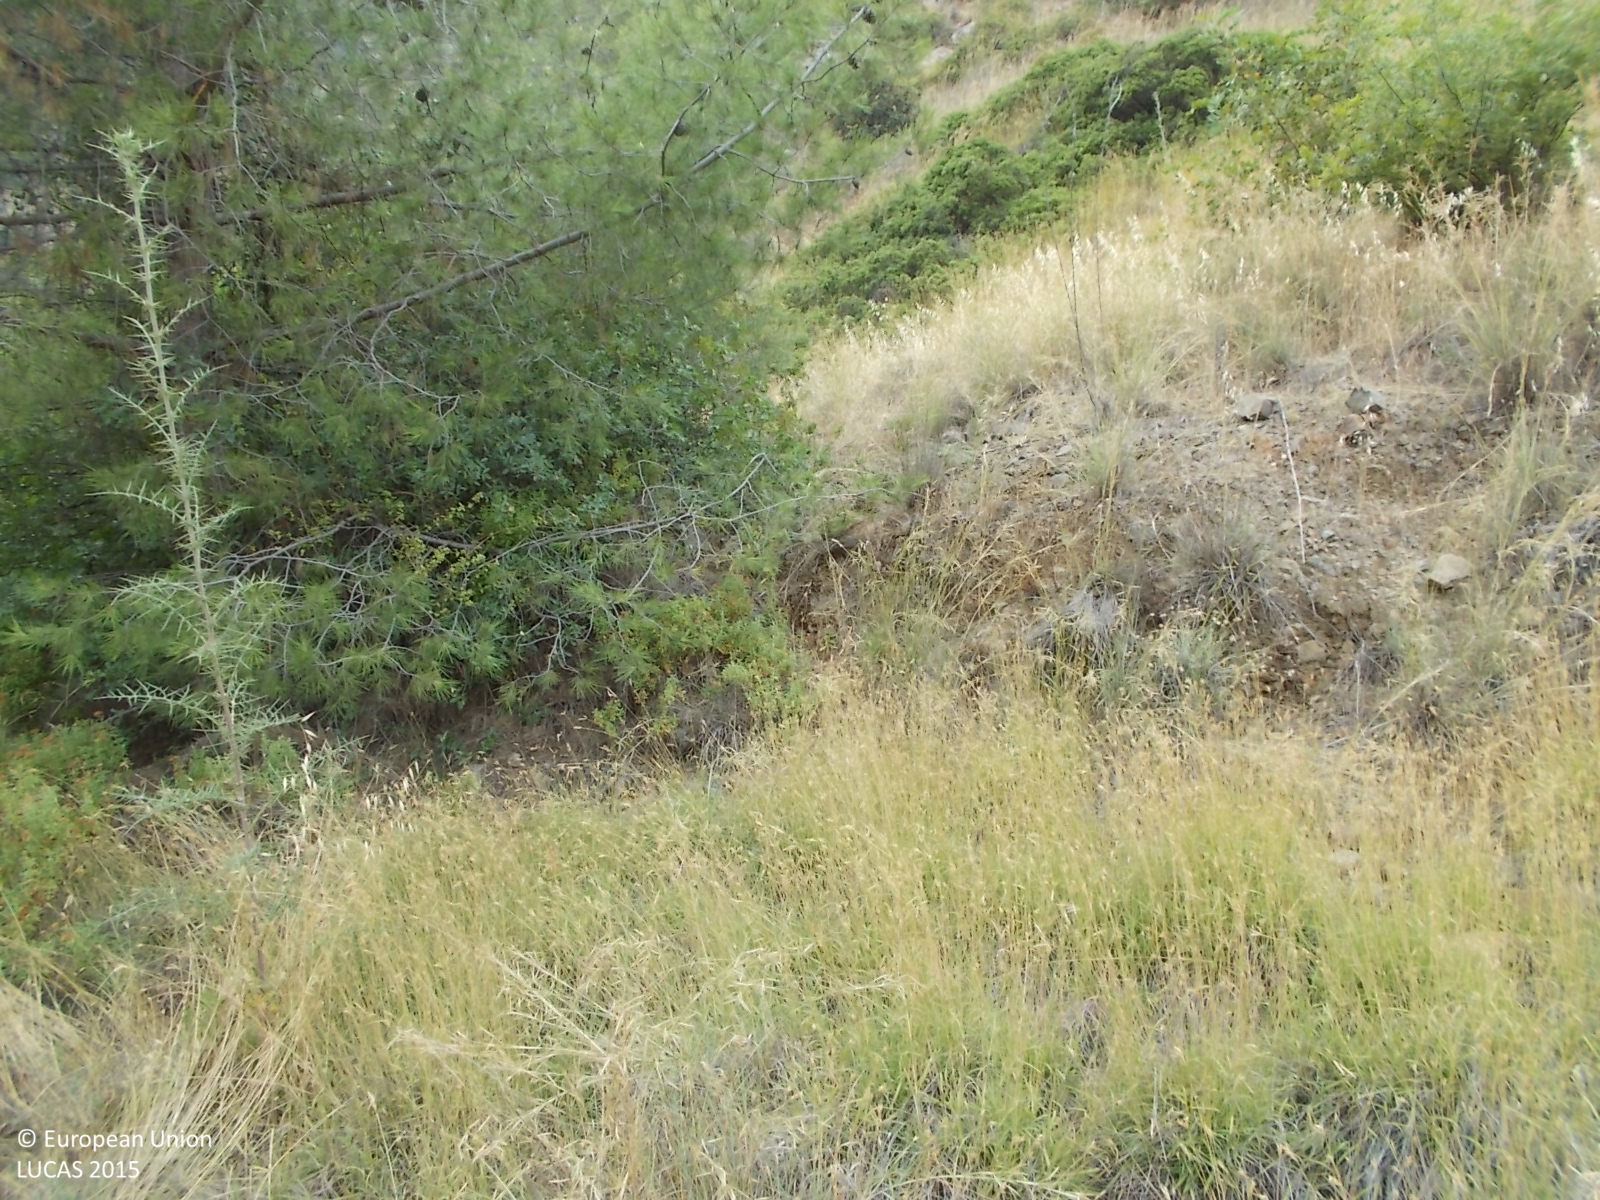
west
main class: Shrubland
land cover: Shrubland without tree cover
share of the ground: 25 - 50 %
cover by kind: shrubs 35 %, herbaceous plants 25 %, consolidated bare surface 20 %, unconsolidated bare surface 20 %
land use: Semi-natural and natural areas not in use
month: June
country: CY
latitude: 35.1611
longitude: 32.6607
